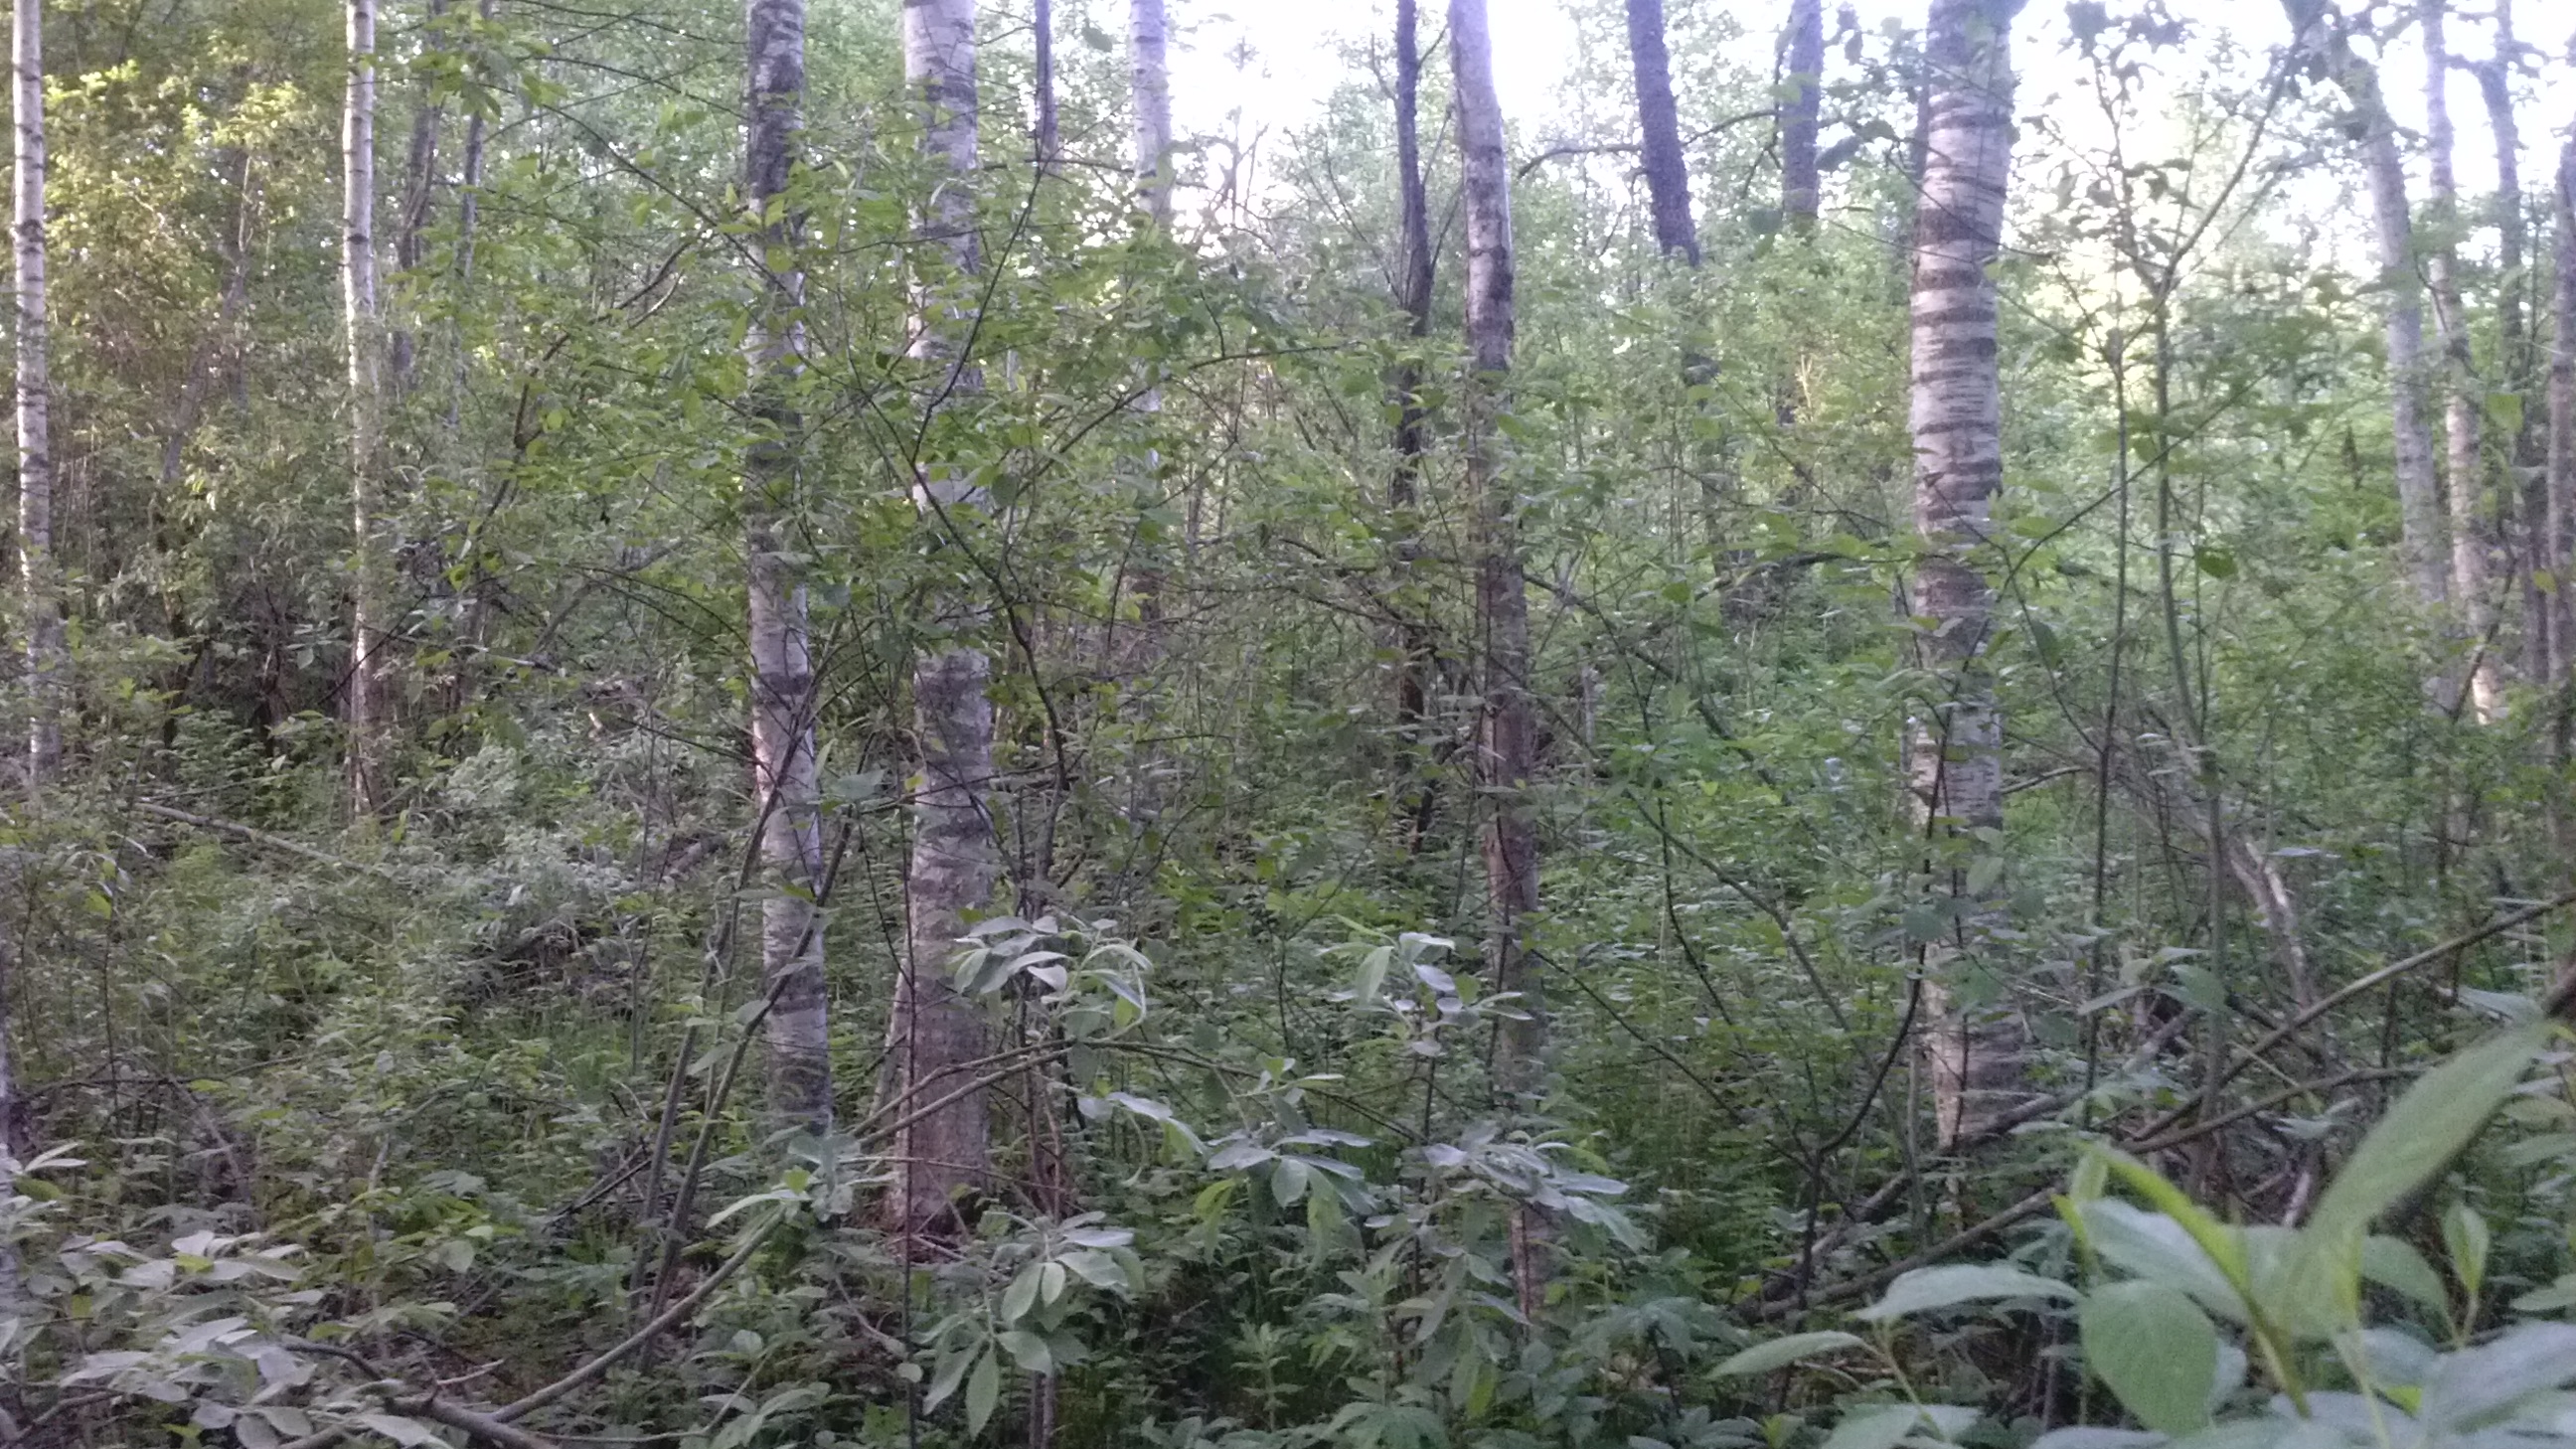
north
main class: Woodland
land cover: Broadleaved woodland
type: non-riverine alder, birch or aspen forest
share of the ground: > 75 %
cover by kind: broadleaved forest trees 95 %, herbaceous plants 5 %
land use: Forestry
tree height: > 5 m
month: June
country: LV
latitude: 56.4088
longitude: 27.9073
